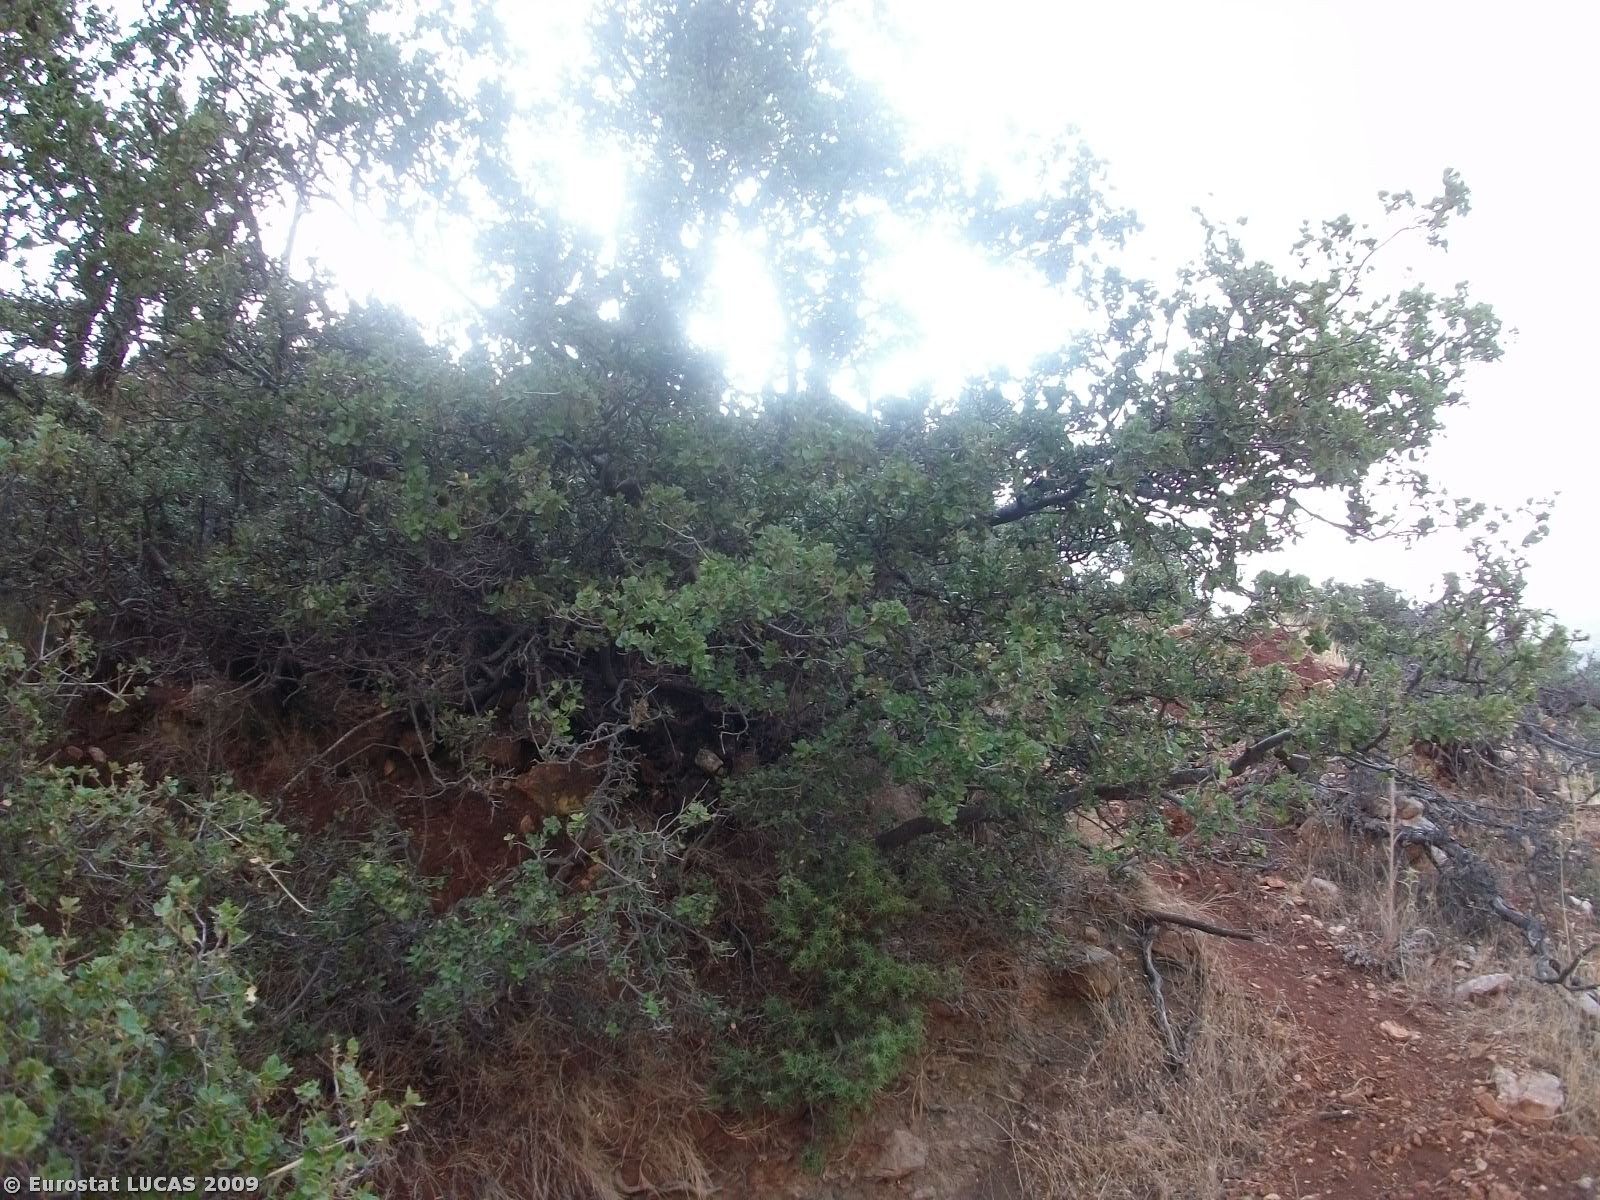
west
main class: Bare land
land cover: Bare land
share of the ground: 50 - 75 %
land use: Road transport
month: August
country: GR
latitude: 37.7431
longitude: 22.5060
